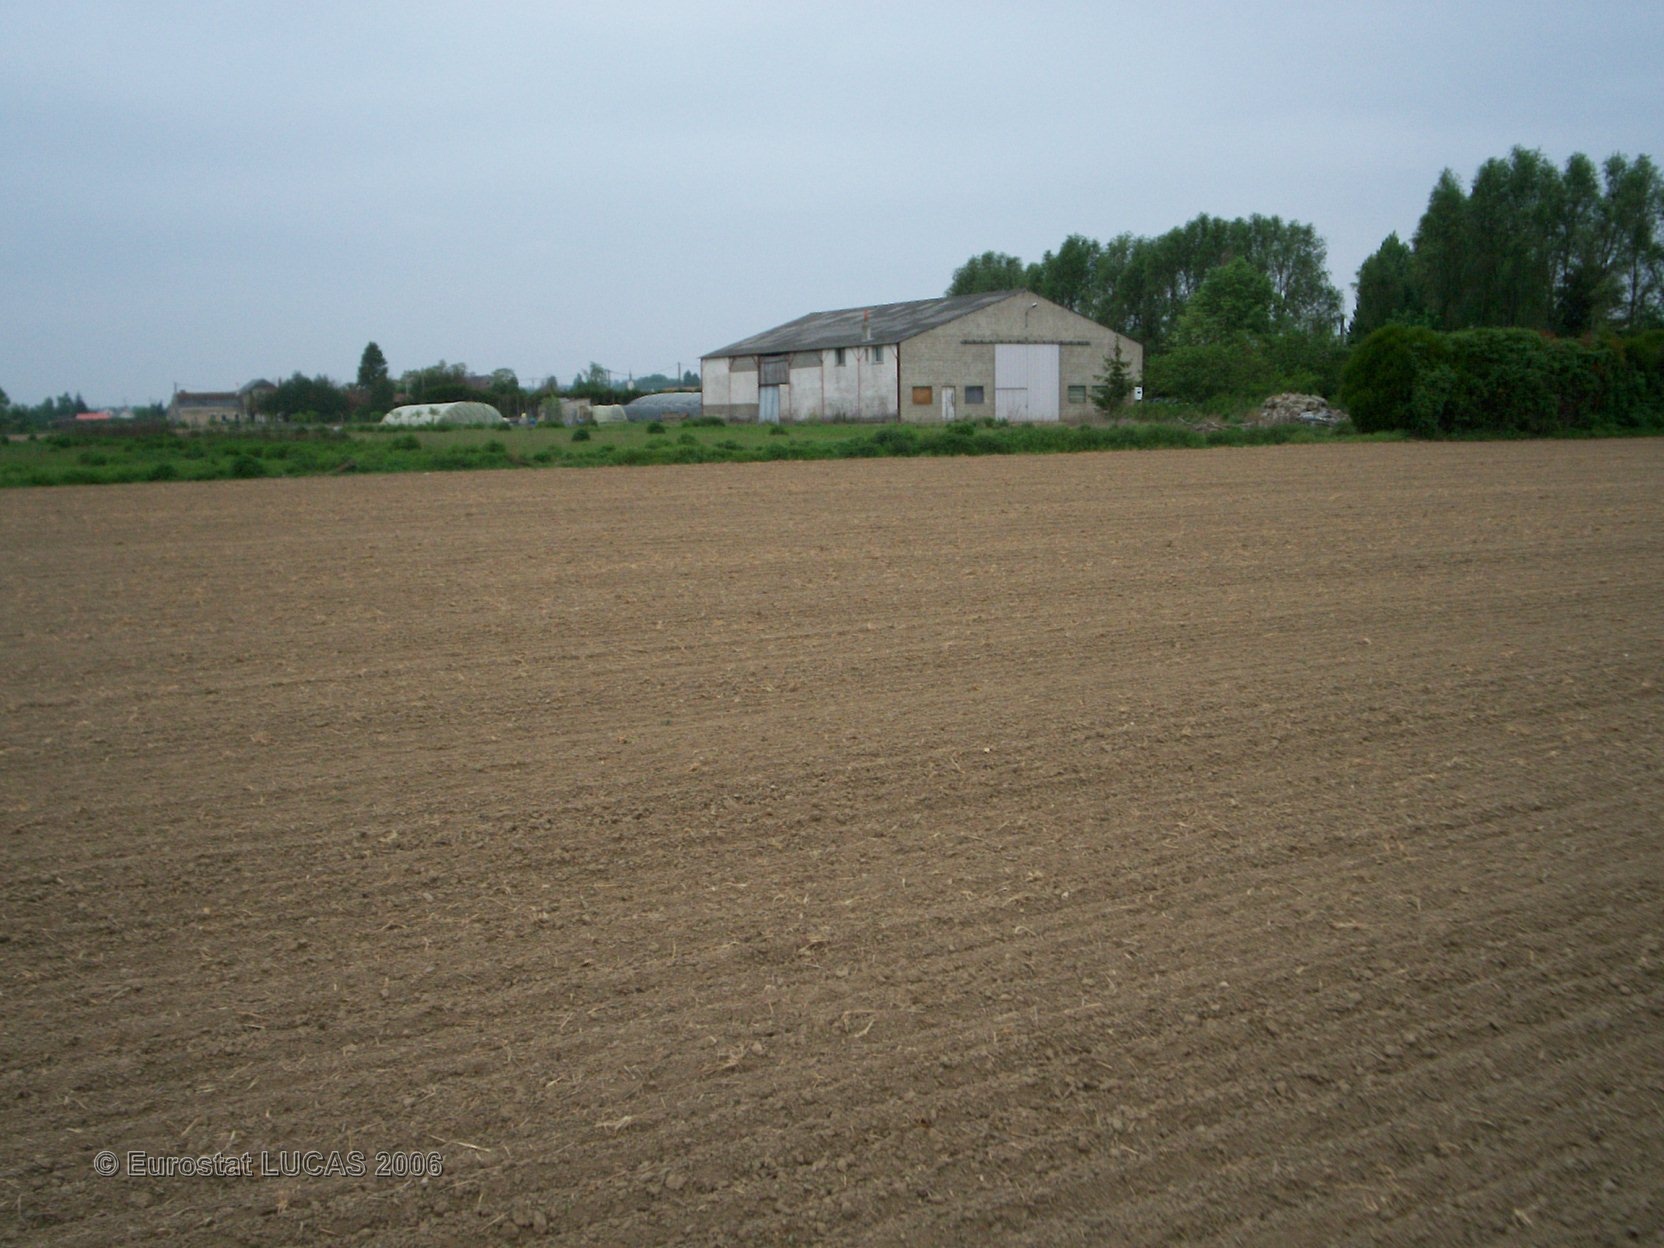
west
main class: Cropland
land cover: Common wheat
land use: Agriculture (excluding fallow land and kitchen gardens)
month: May
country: FR
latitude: 47.3629
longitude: 0.5387
